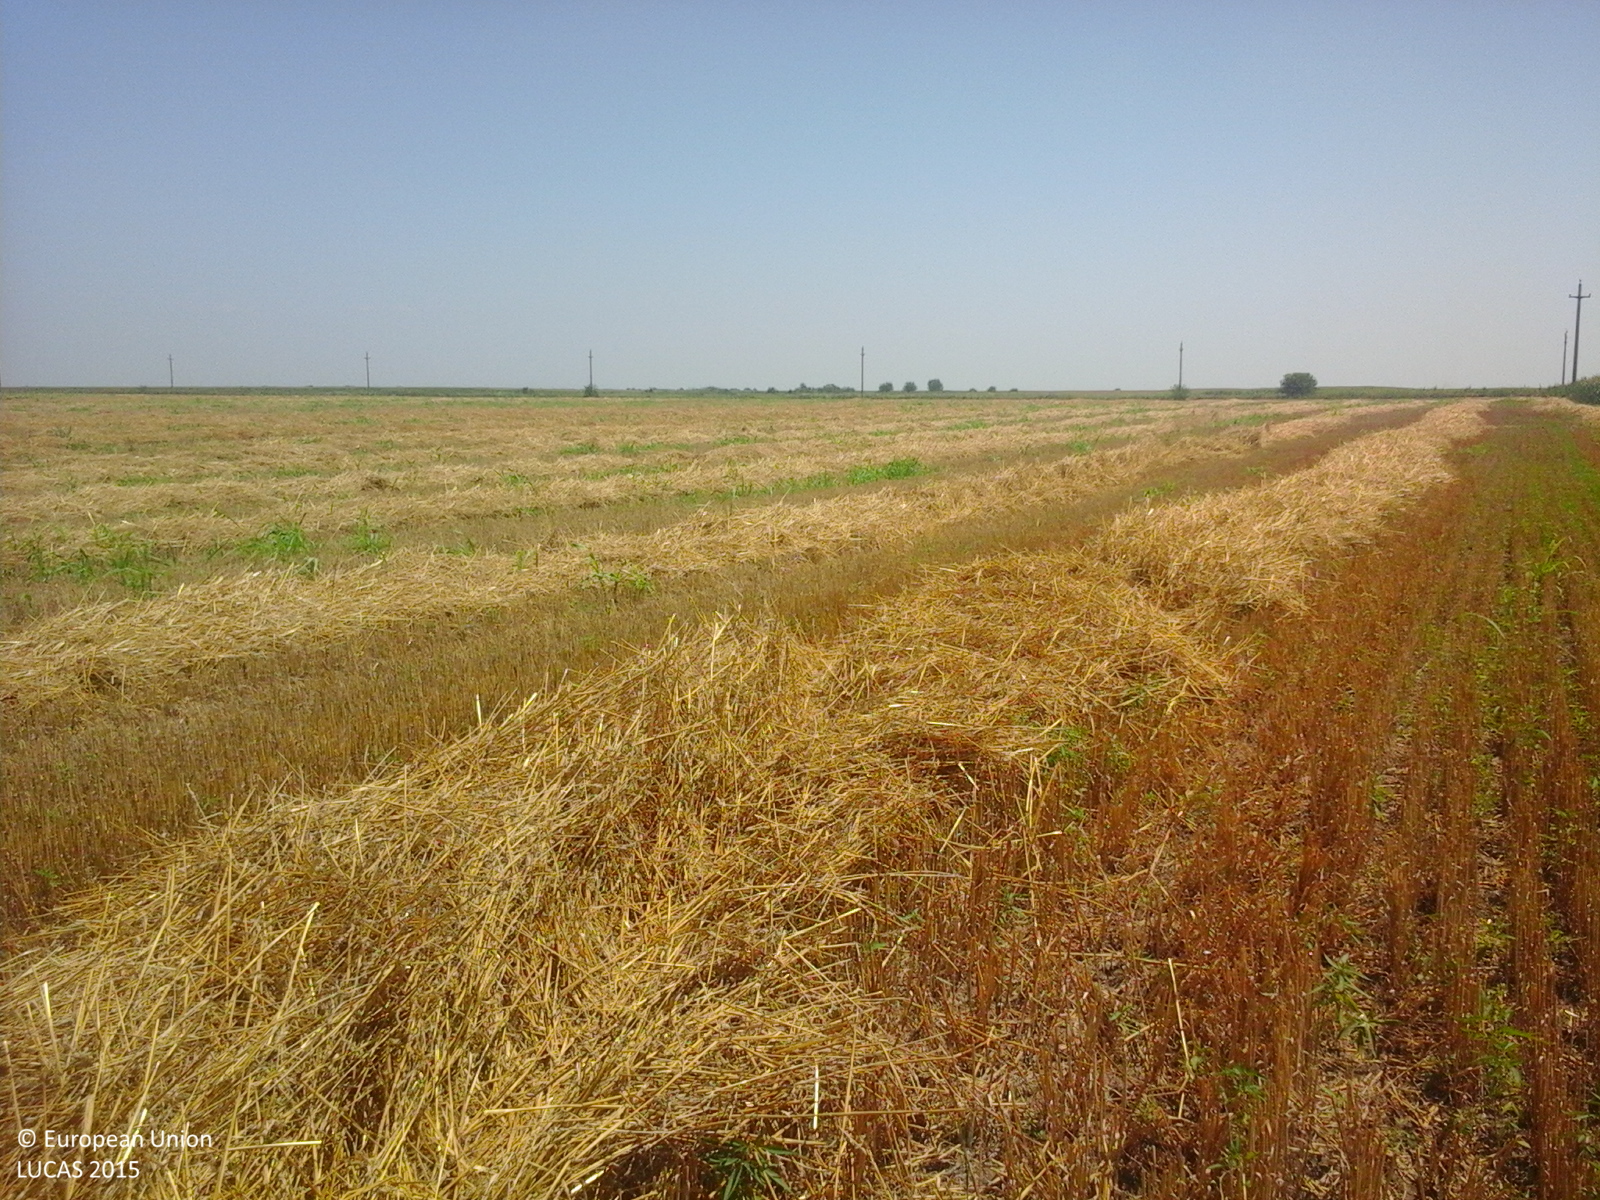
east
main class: Cropland
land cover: Common wheat
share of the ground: 50 - 75 %
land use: Agriculture (excluding fallow land and kitchen gardens)
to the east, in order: Common wheat
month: July
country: RO
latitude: 44.4622
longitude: 27.1120
